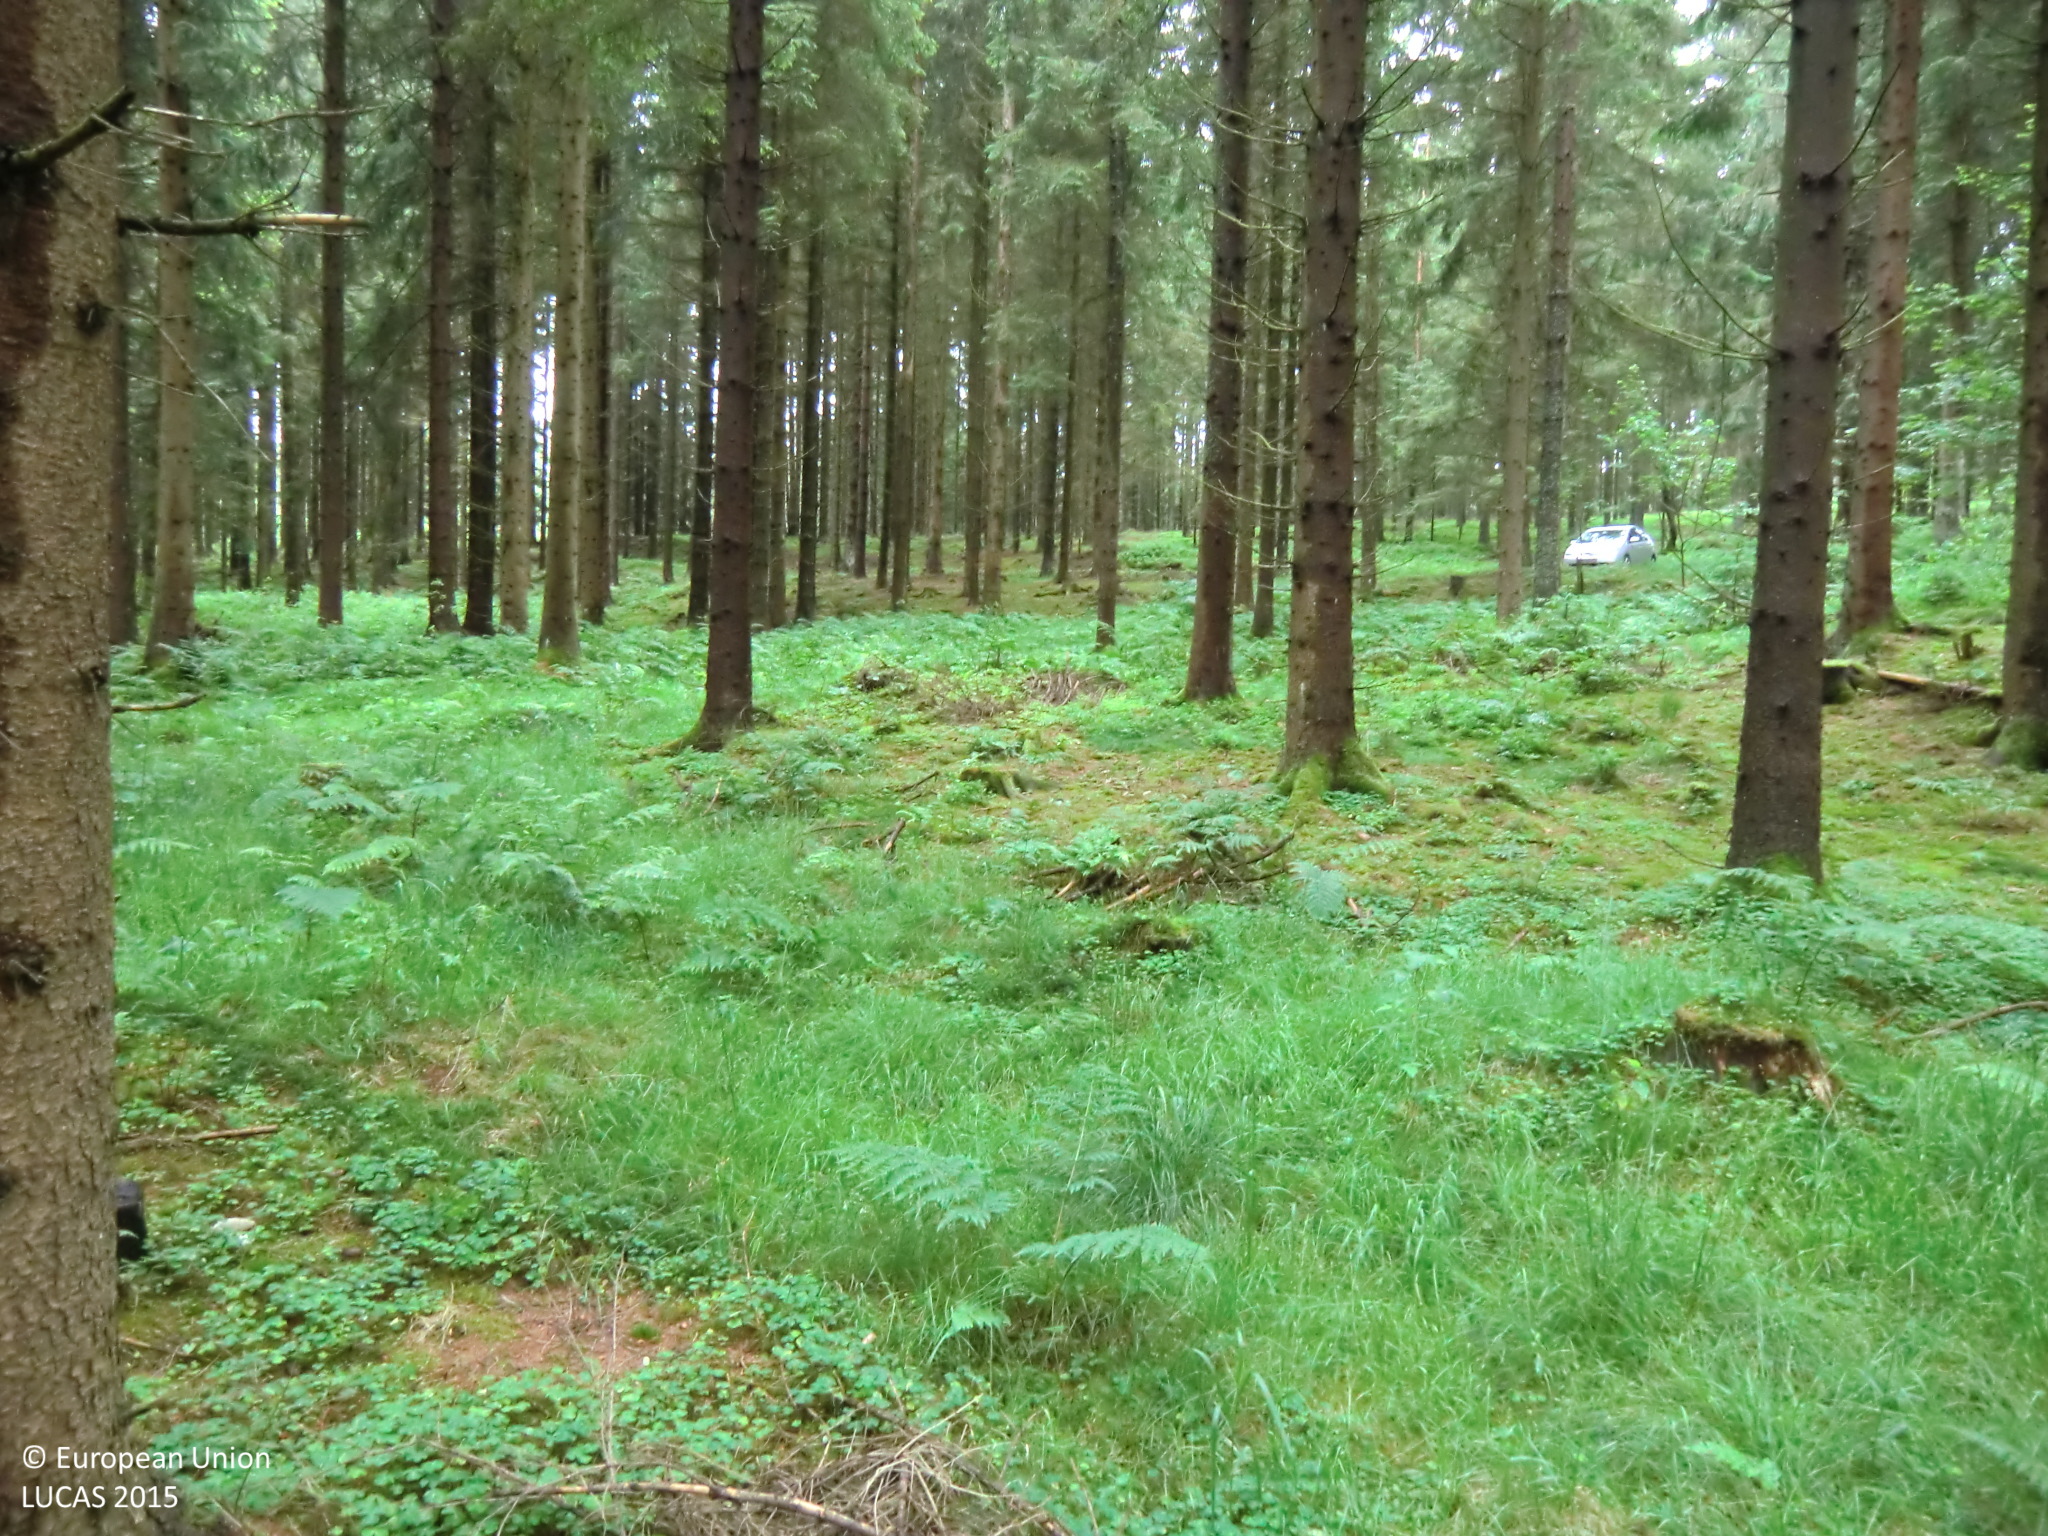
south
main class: Woodland
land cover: Spruce dominated coniferous woodland
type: hemiboreal forest and nemoral coniferous forest and mixed broadleaved-coniferous forest
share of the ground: > 75 %
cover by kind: coniferous forest trees 75 %, herbaceous plants 15 %, lichens and mosses 10 %
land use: Forestry
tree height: > 5 m
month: June
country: AT
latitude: 48.4661
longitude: 14.6940
